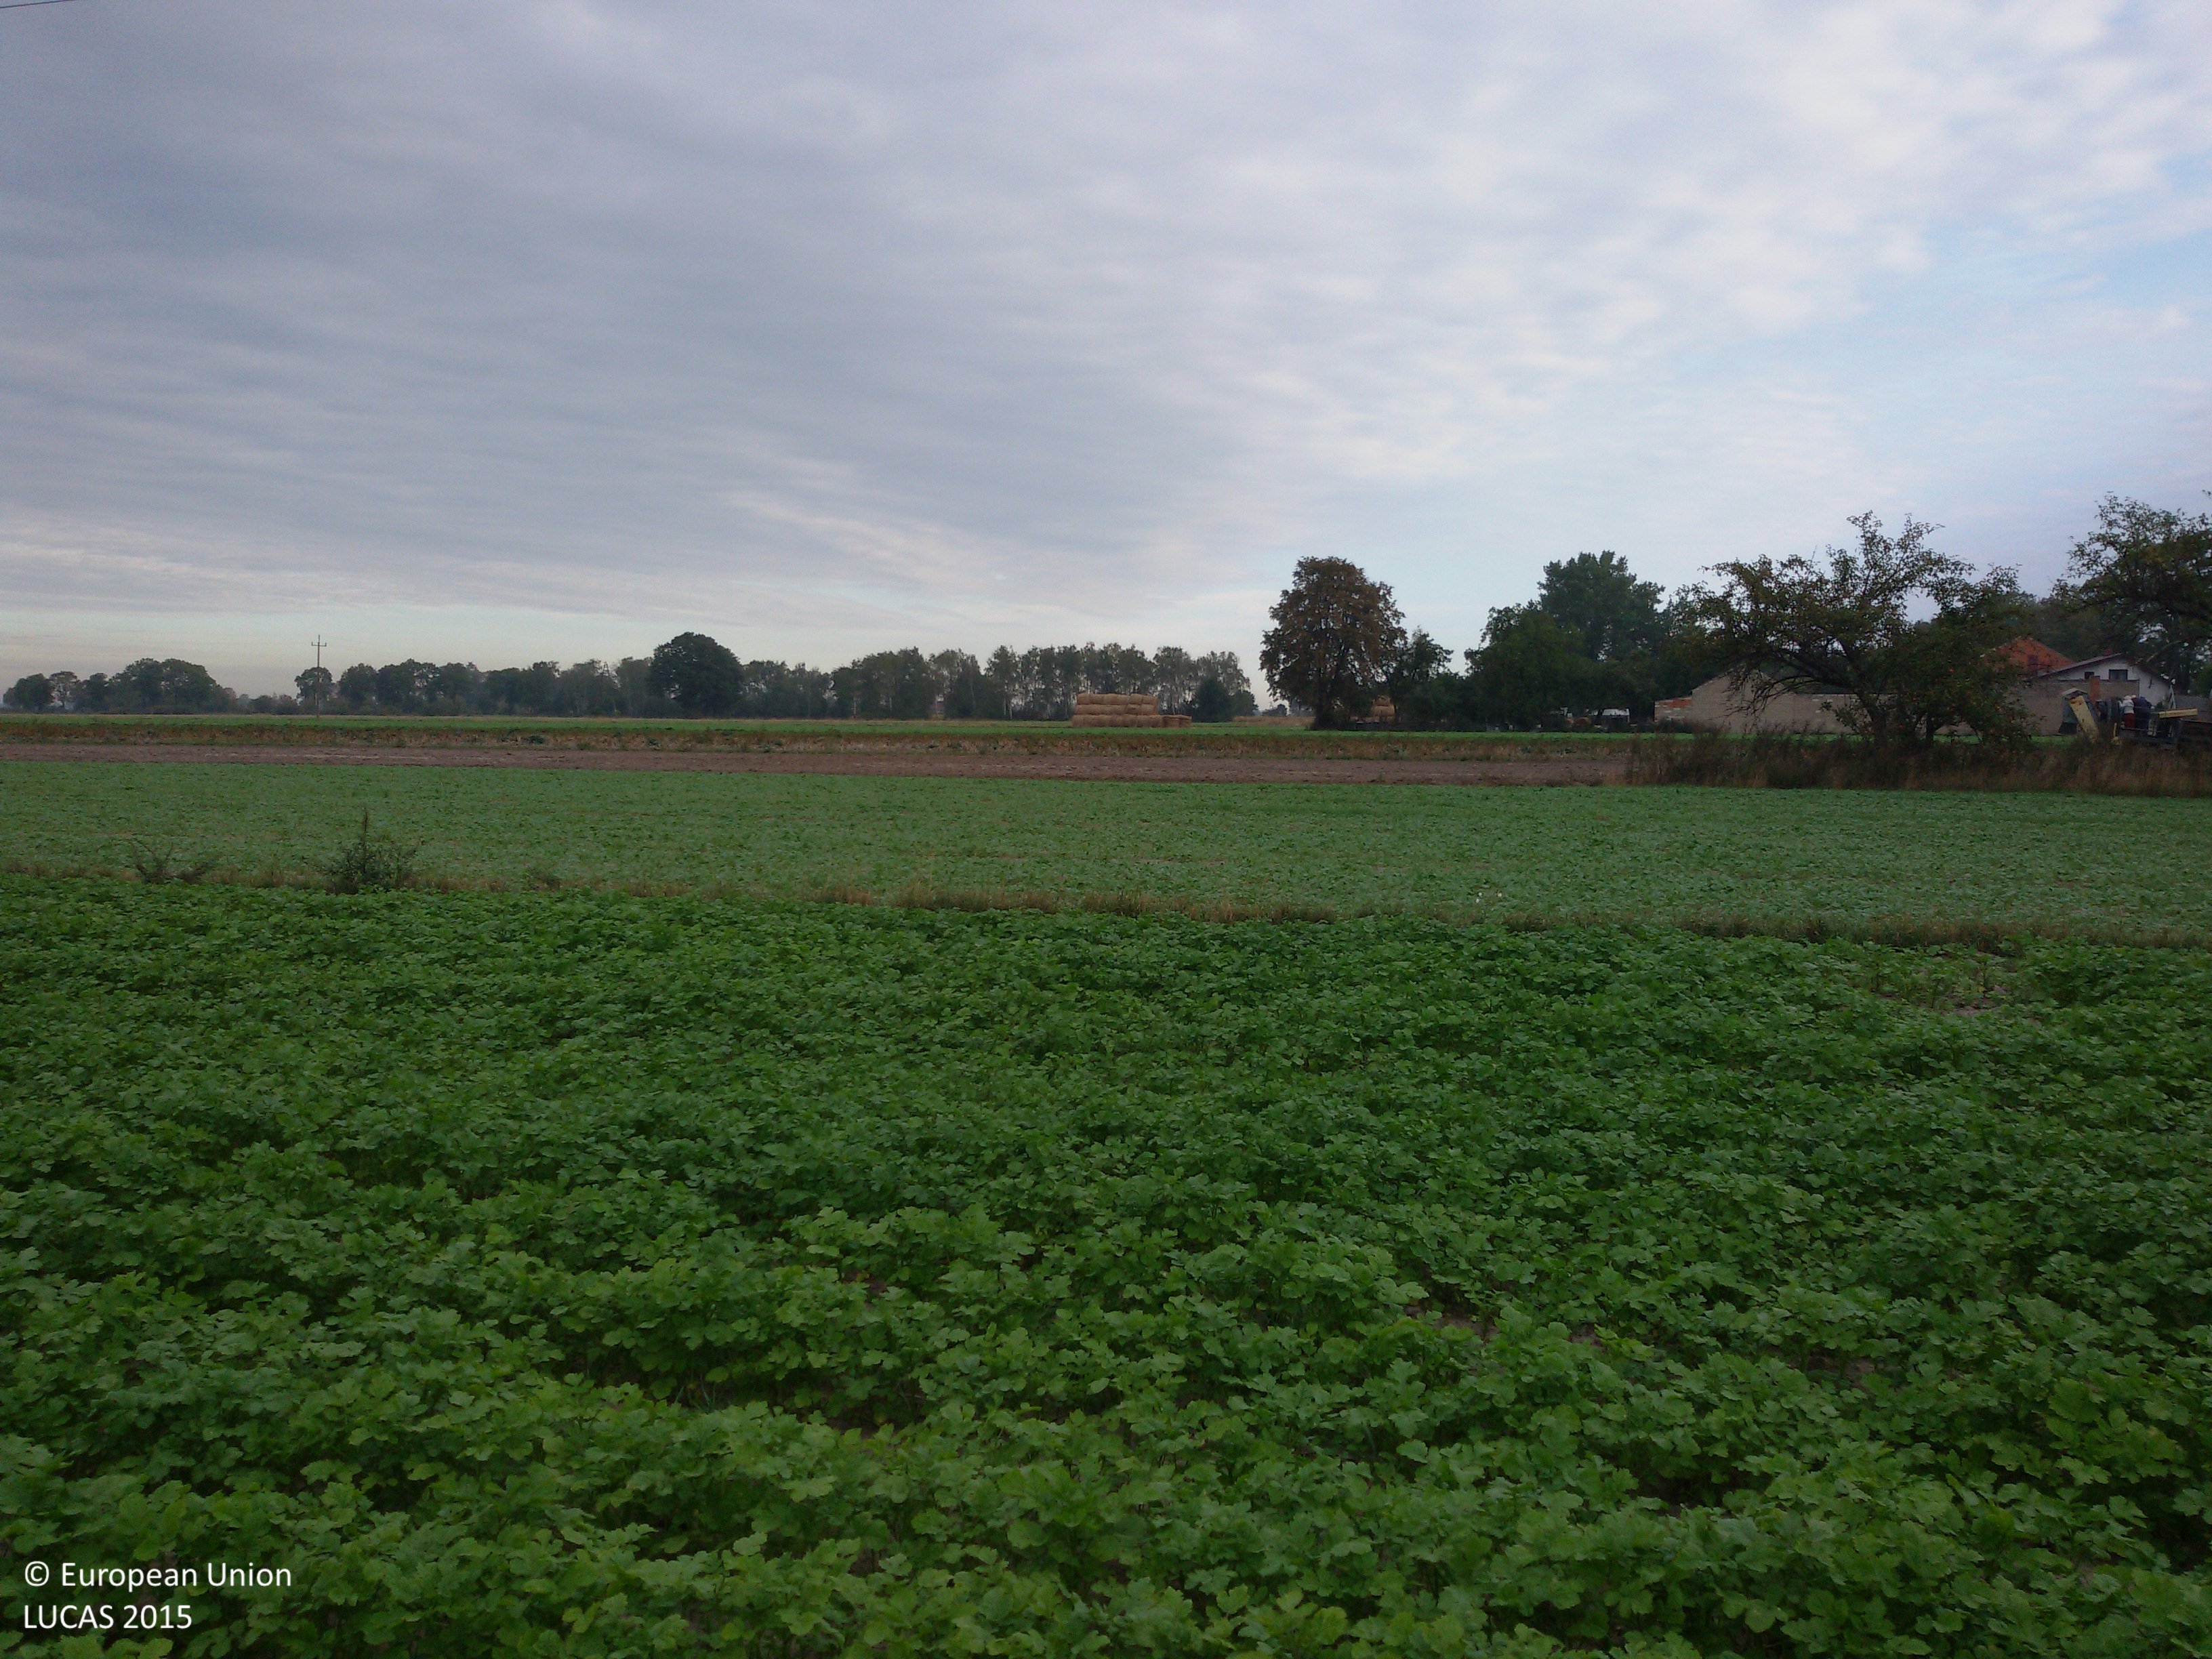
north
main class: Cropland
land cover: Rape and turnip rape
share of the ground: > 75 %
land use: Agriculture (excluding fallow land and kitchen gardens)
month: September
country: PL
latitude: 52.2895
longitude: 17.9763
